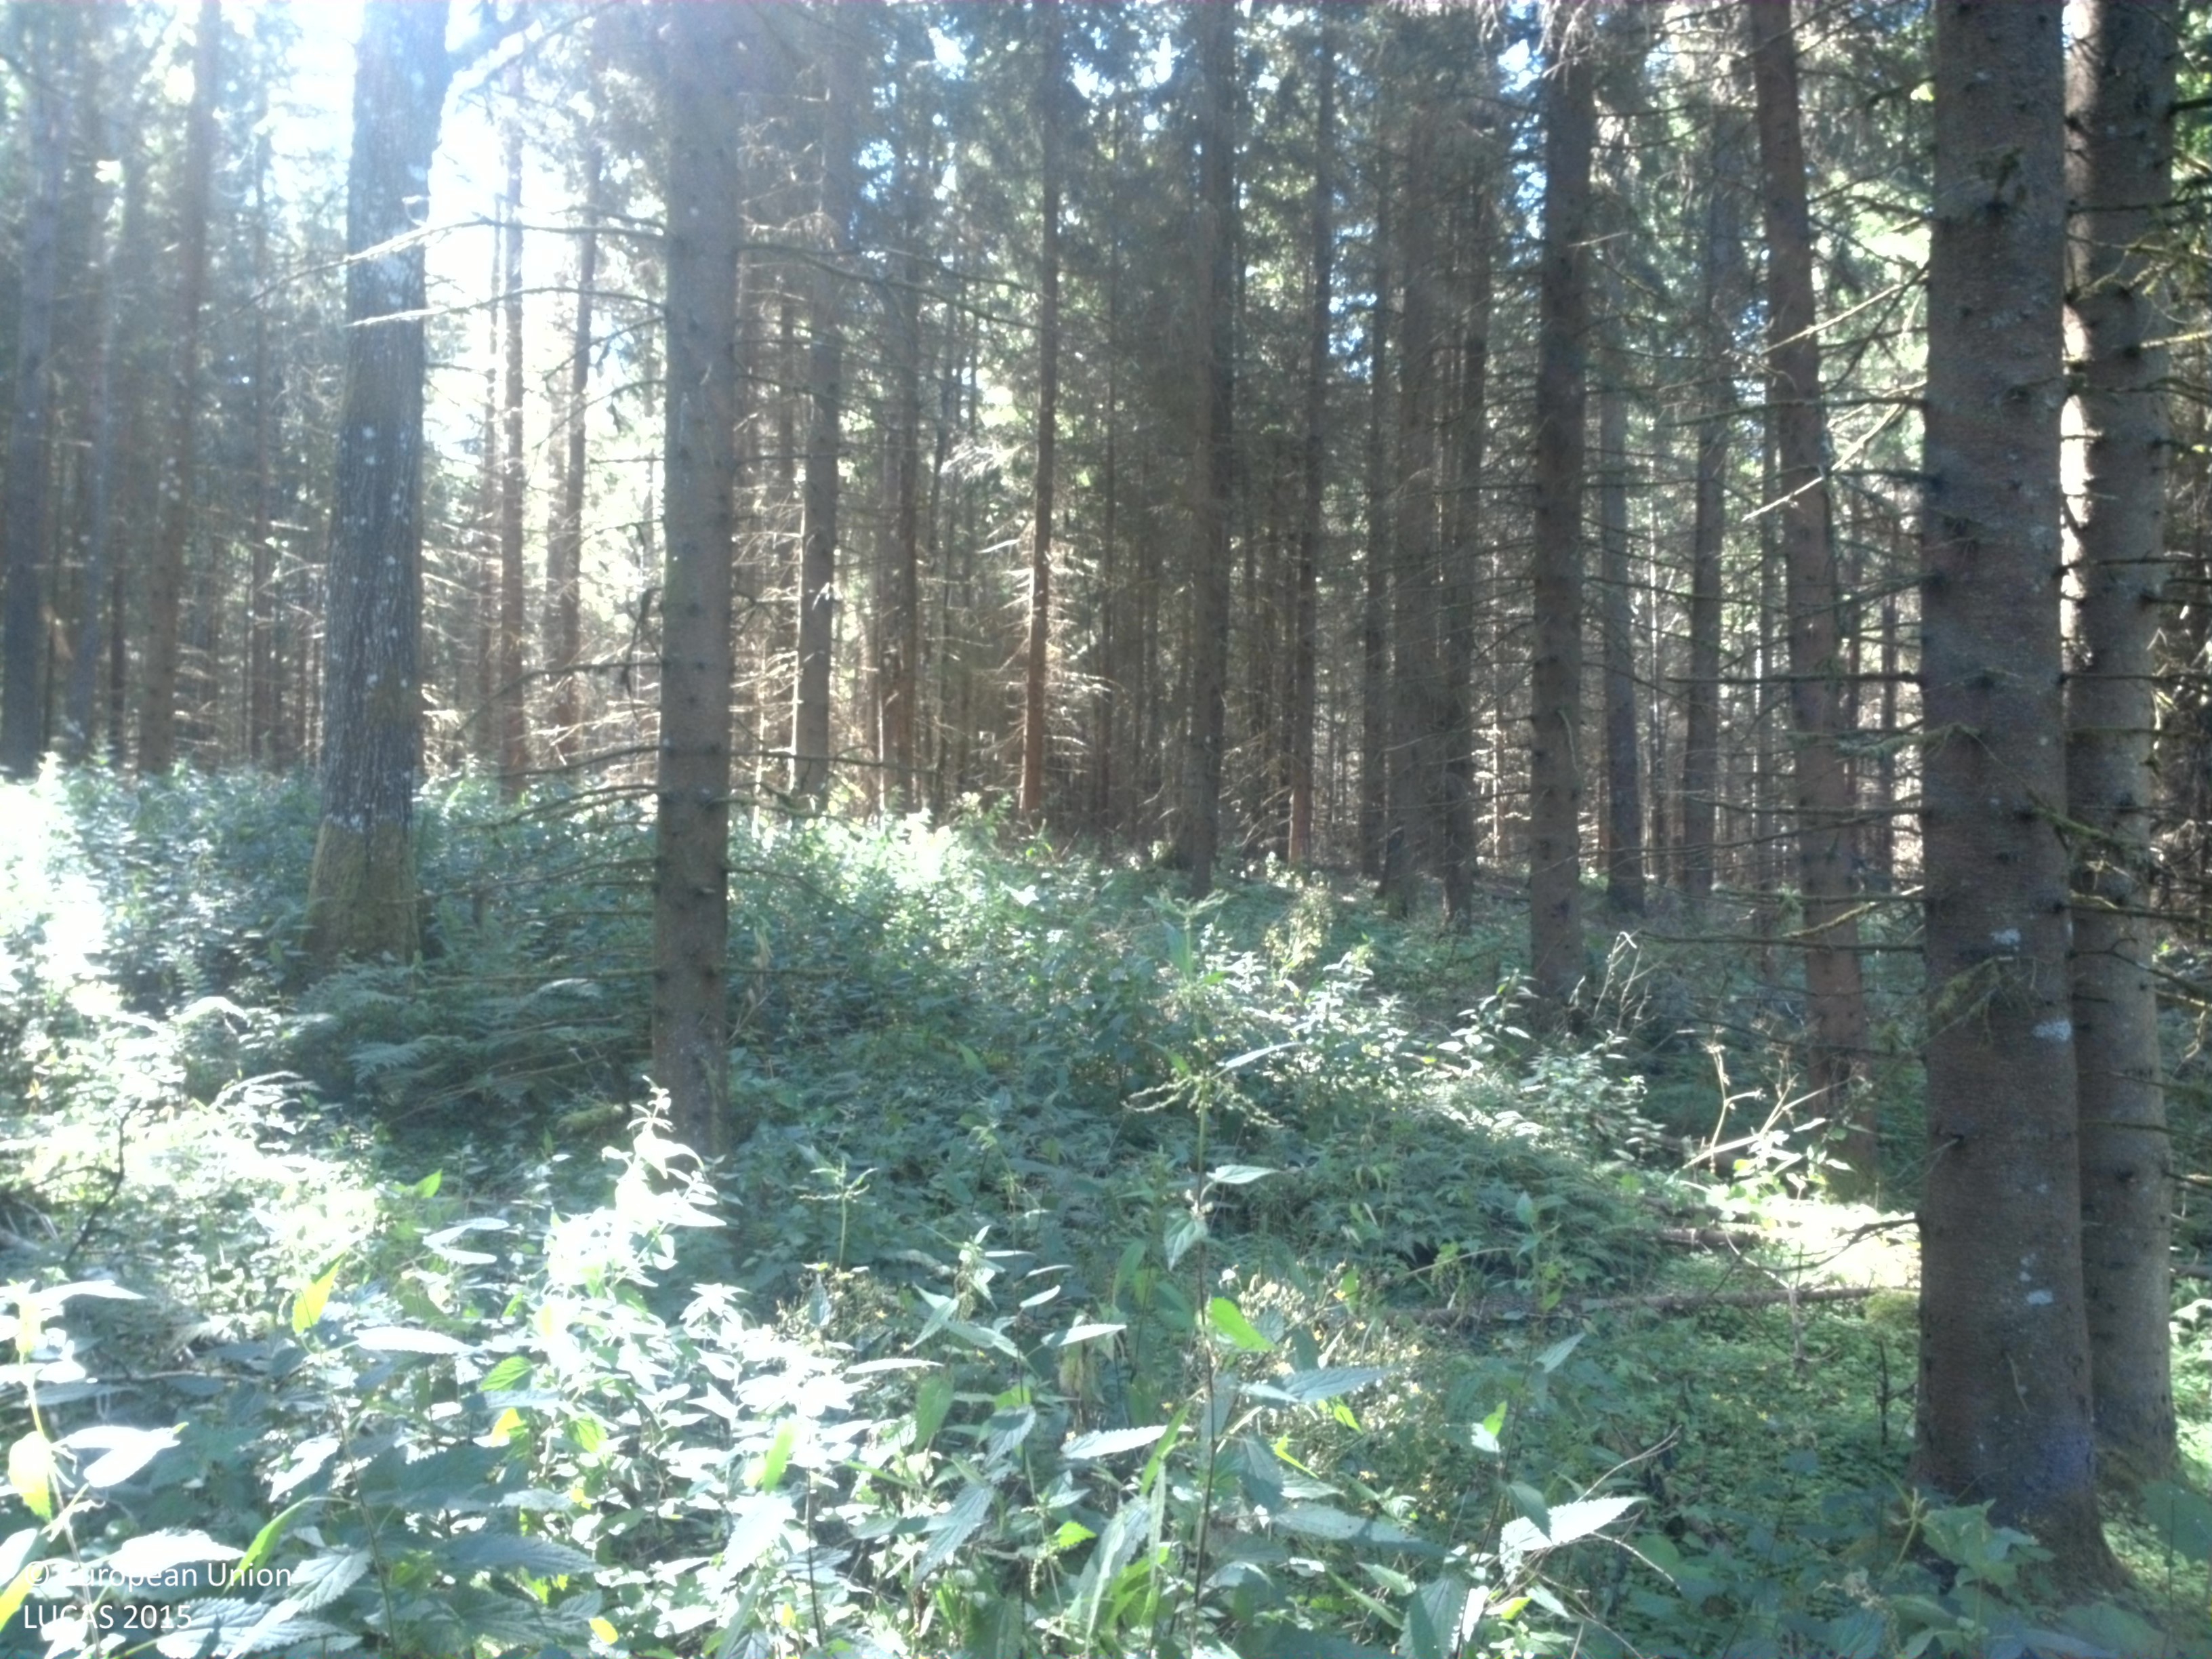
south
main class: Woodland
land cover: Spruce dominated coniferous woodland
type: boreal forest
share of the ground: 50 - 75 %
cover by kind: coniferous forest trees 55 %, herbaceous plants 30 %, lichens and mosses 10 %, broadleaved forest trees 5 %
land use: Forestry
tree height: > 5 m
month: August
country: SE
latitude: 57.9992
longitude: 13.2941
